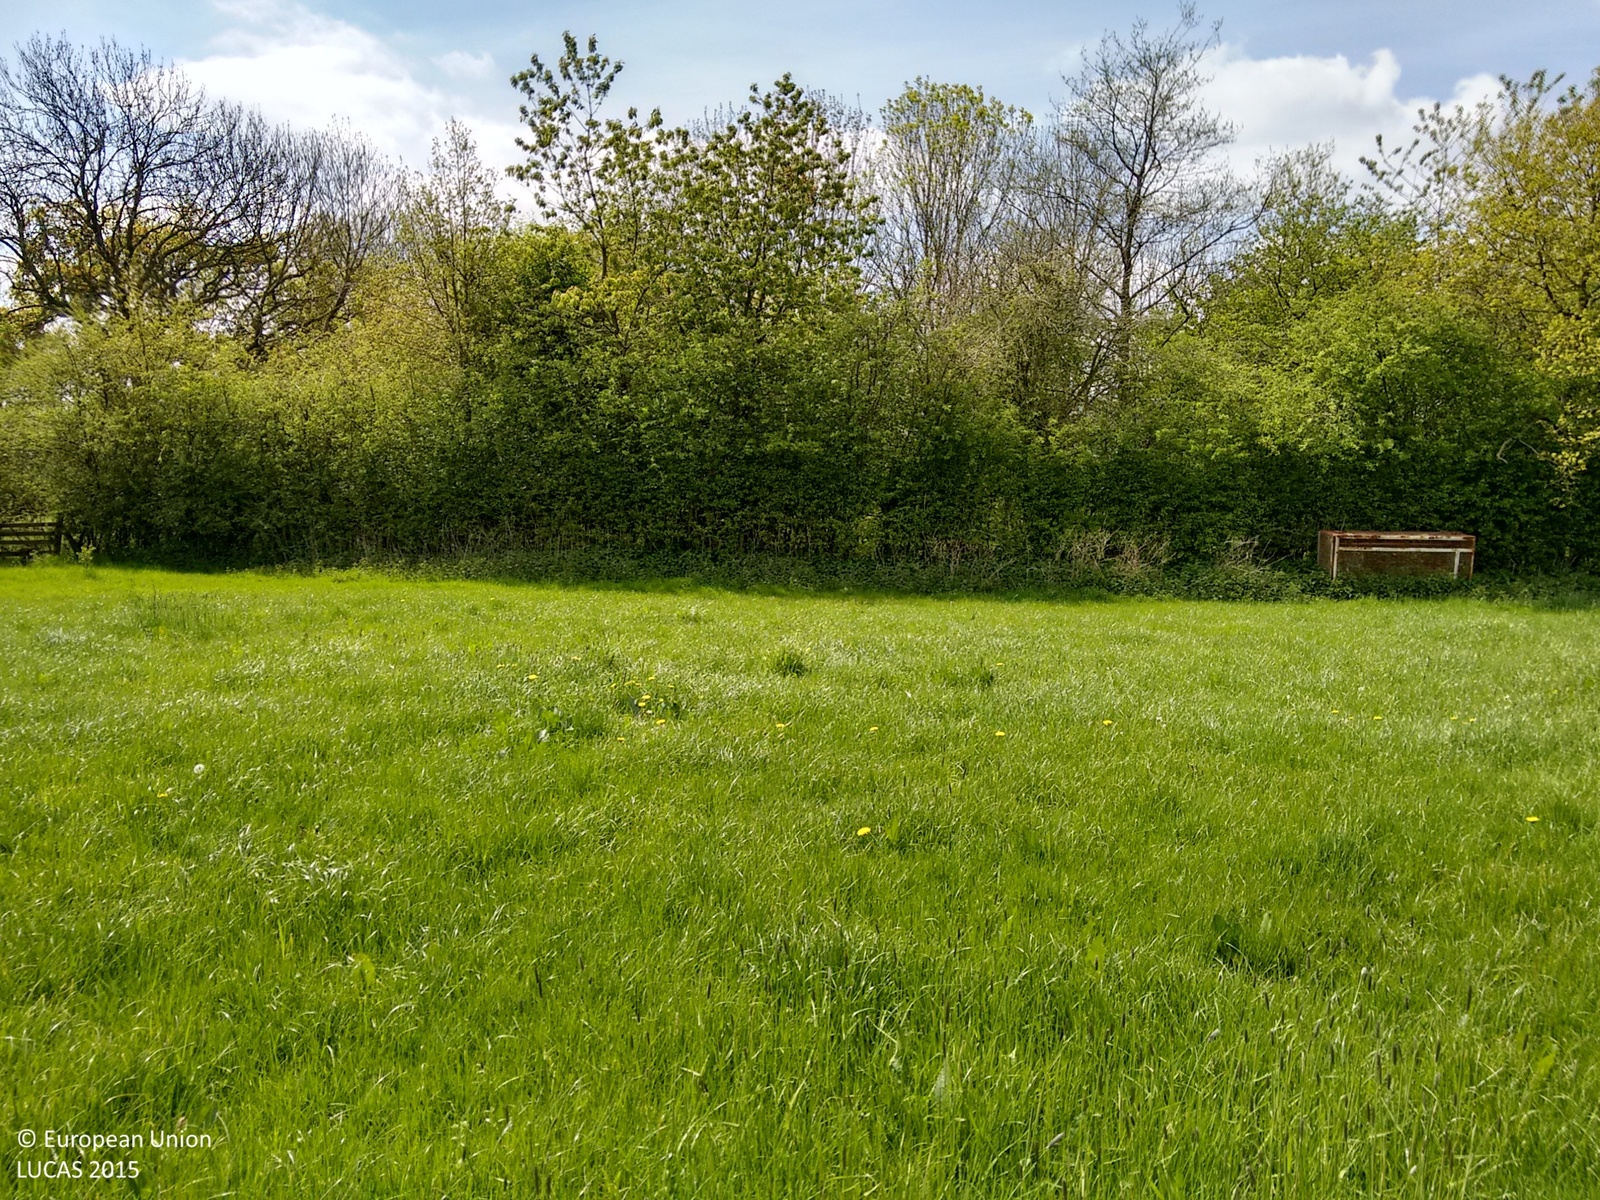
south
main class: Grassland
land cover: Grassland without tree/shrub cover
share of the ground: > 75 %
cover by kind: herbaceous plants 100 %
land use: Agriculture (excluding fallow land and kitchen gardens)
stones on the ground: < 10 %
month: May
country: GB
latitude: 53.8296
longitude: -2.6324
